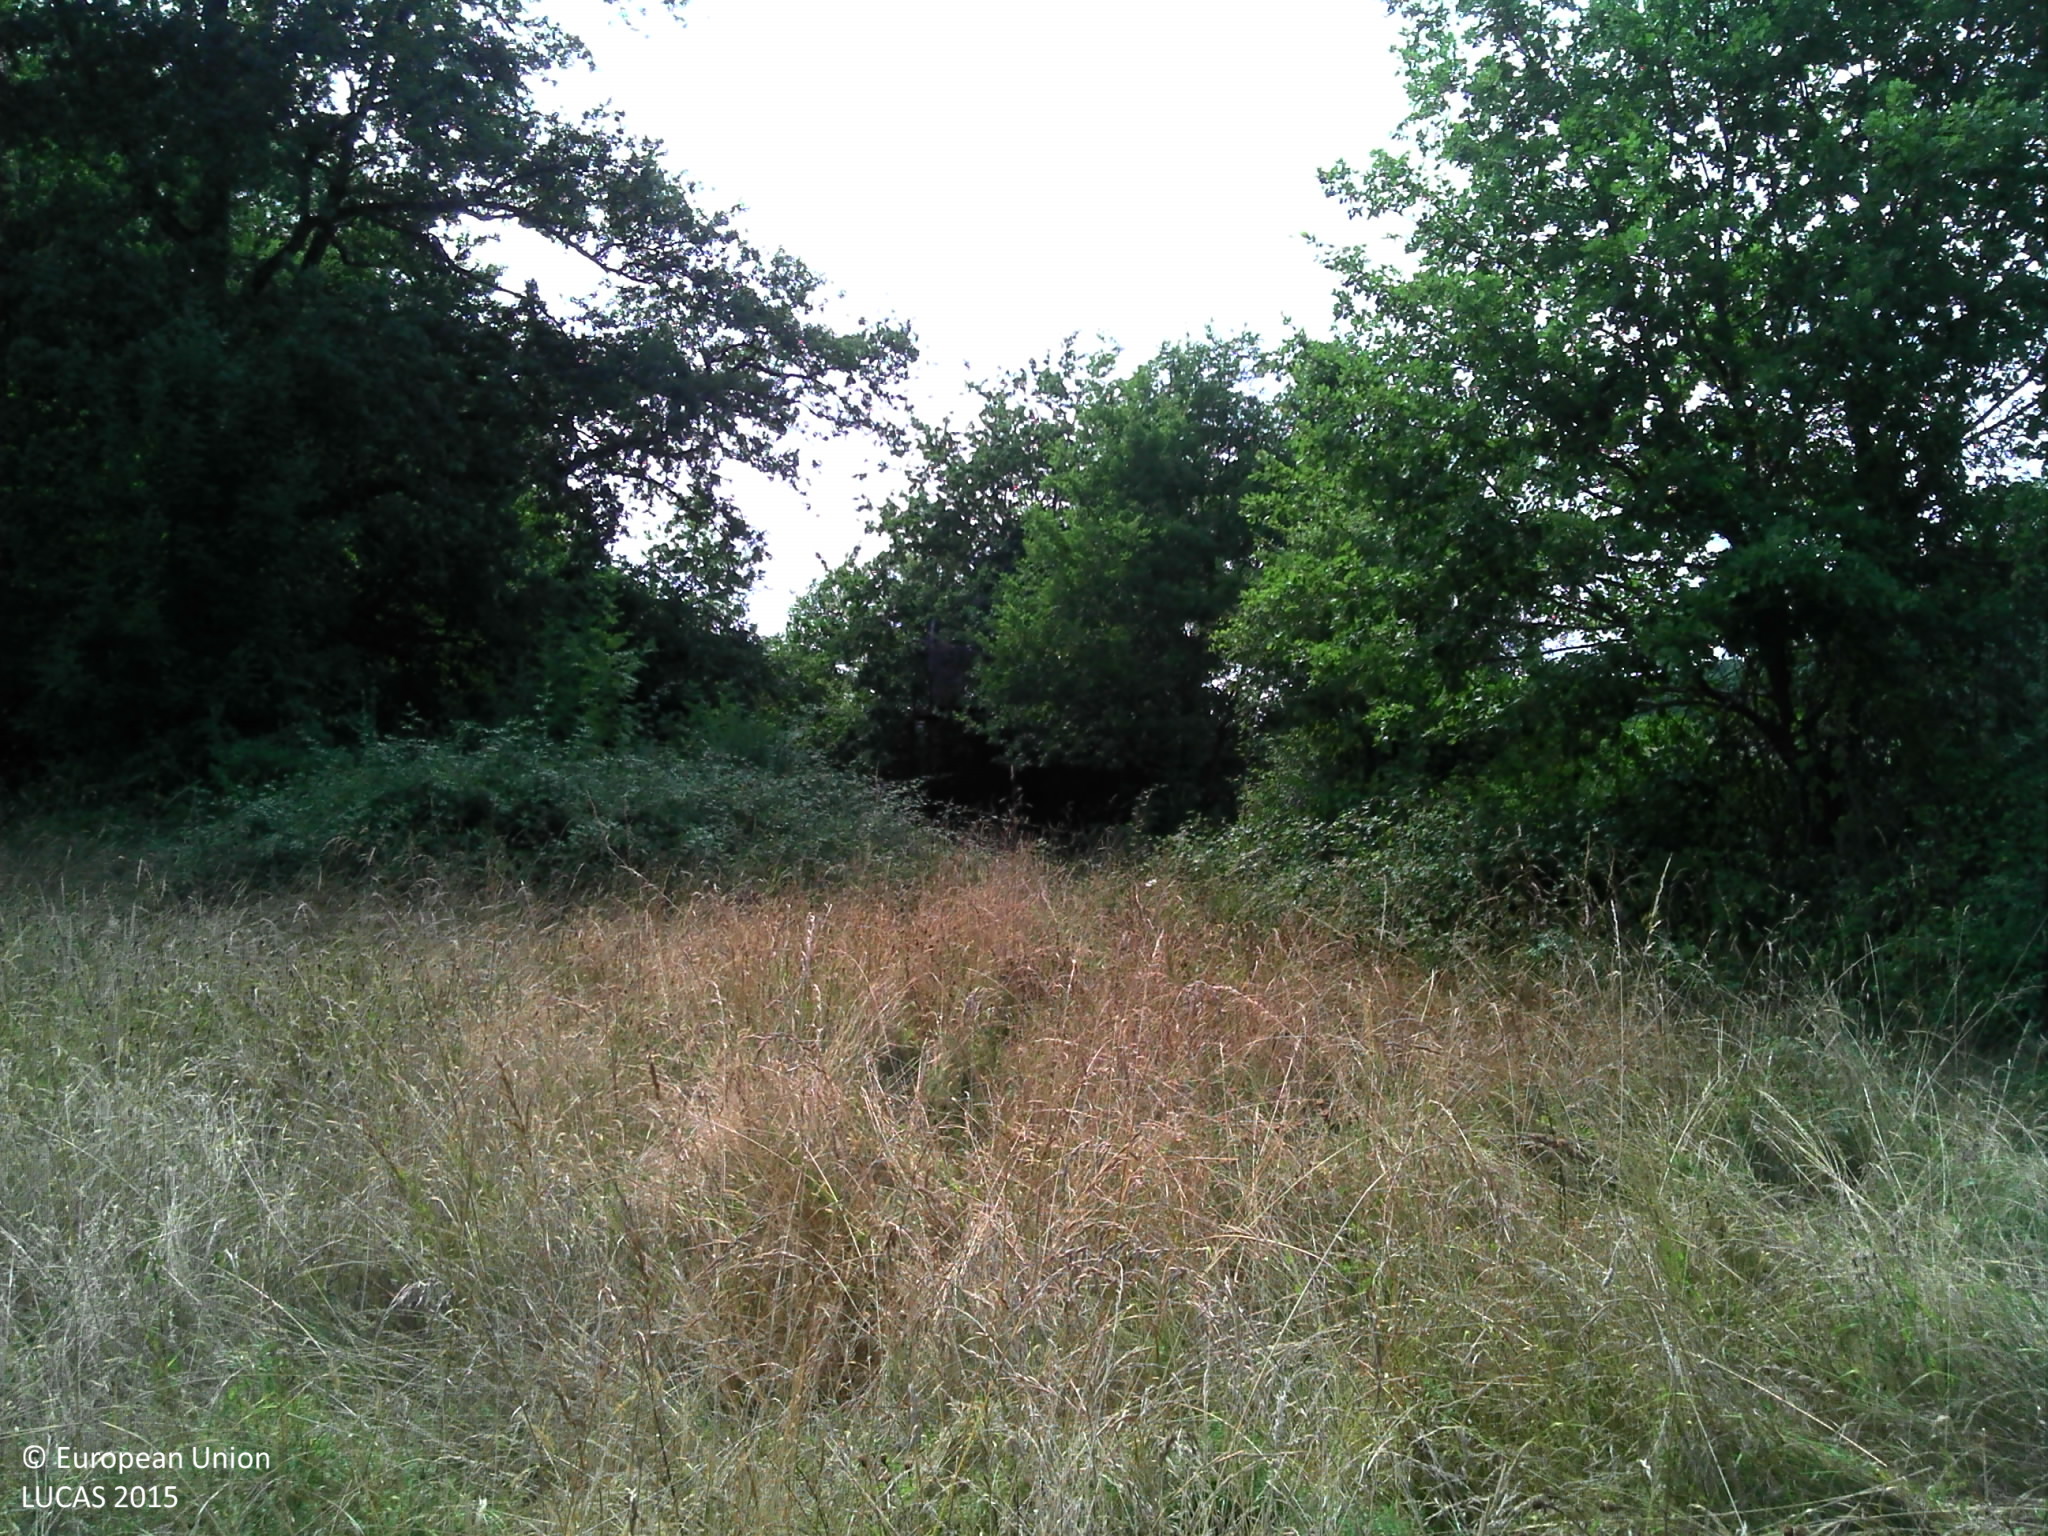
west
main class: Grassland
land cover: Grassland without tree/shrub cover
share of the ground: > 75 %
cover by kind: herbaceous plants 90 %, shrubs 5 %, unconsolidated bare surface 5 %
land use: Agriculture (excluding fallow land and kitchen gardens)
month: July
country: FR
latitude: 45.0619
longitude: 0.5538
